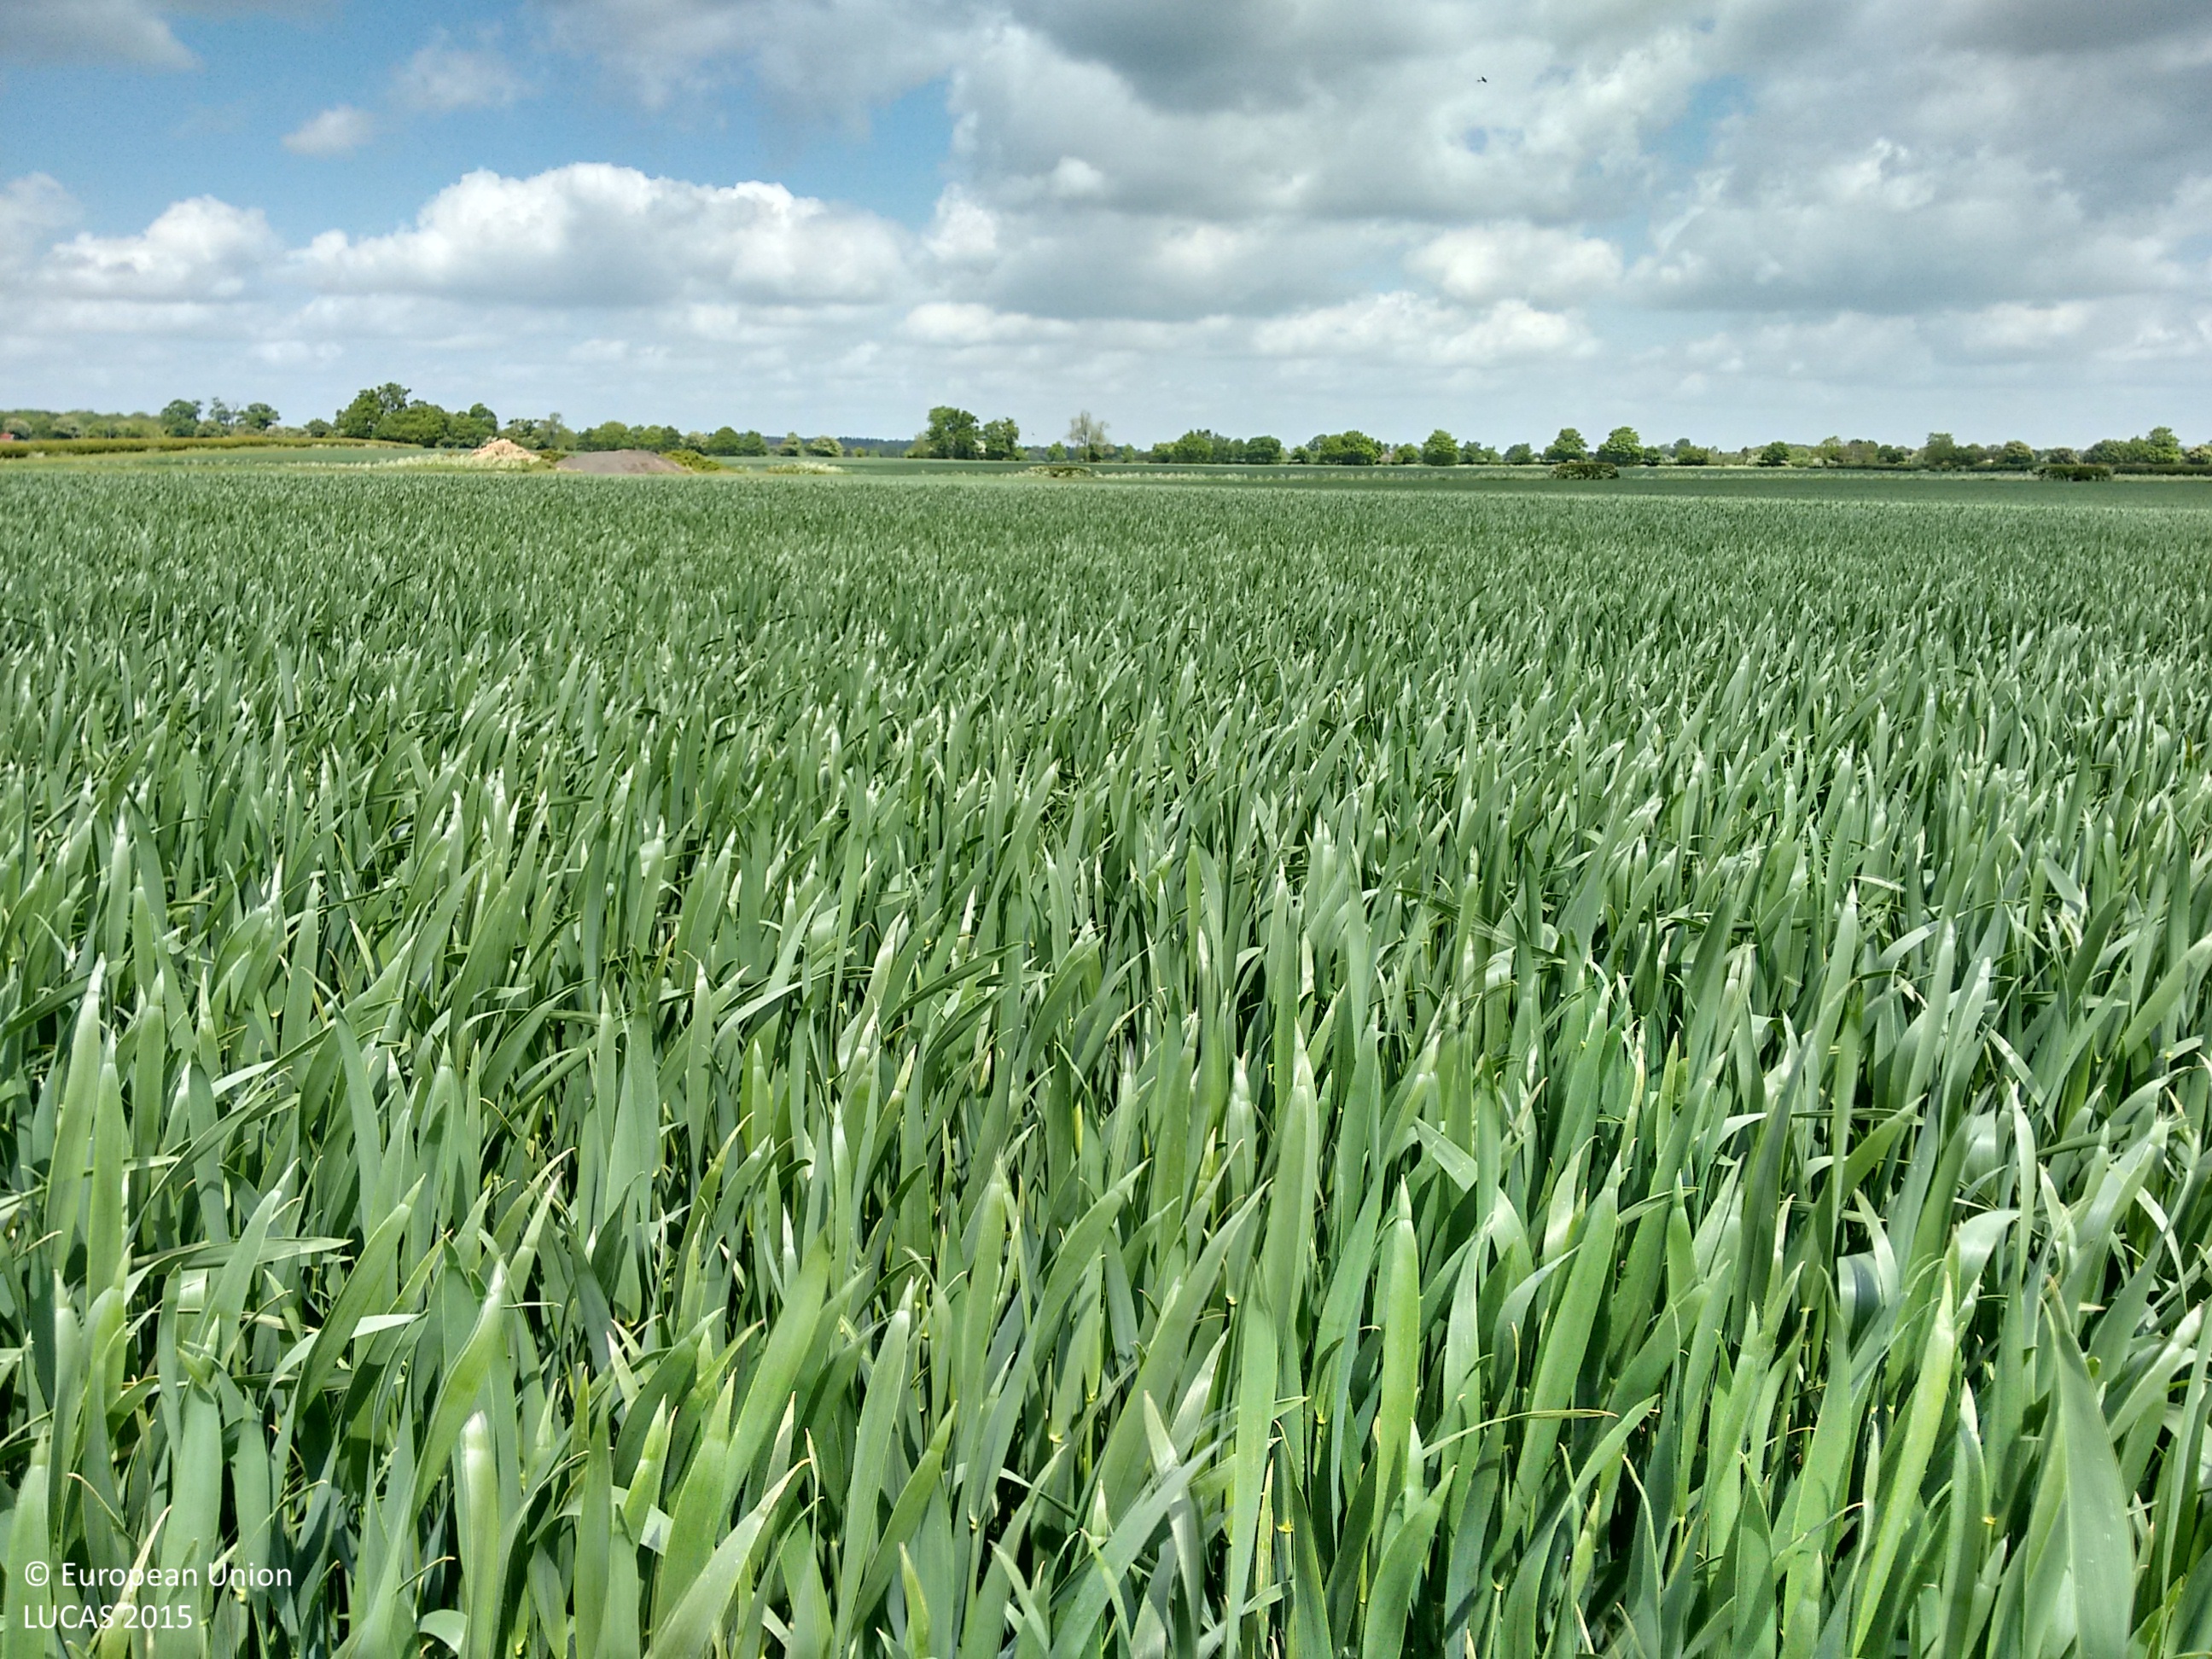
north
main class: Cropland
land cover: Common wheat
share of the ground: > 75 %
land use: Agriculture (excluding fallow land and kitchen gardens)
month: May
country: GB
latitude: 52.0536
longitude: -0.3174
